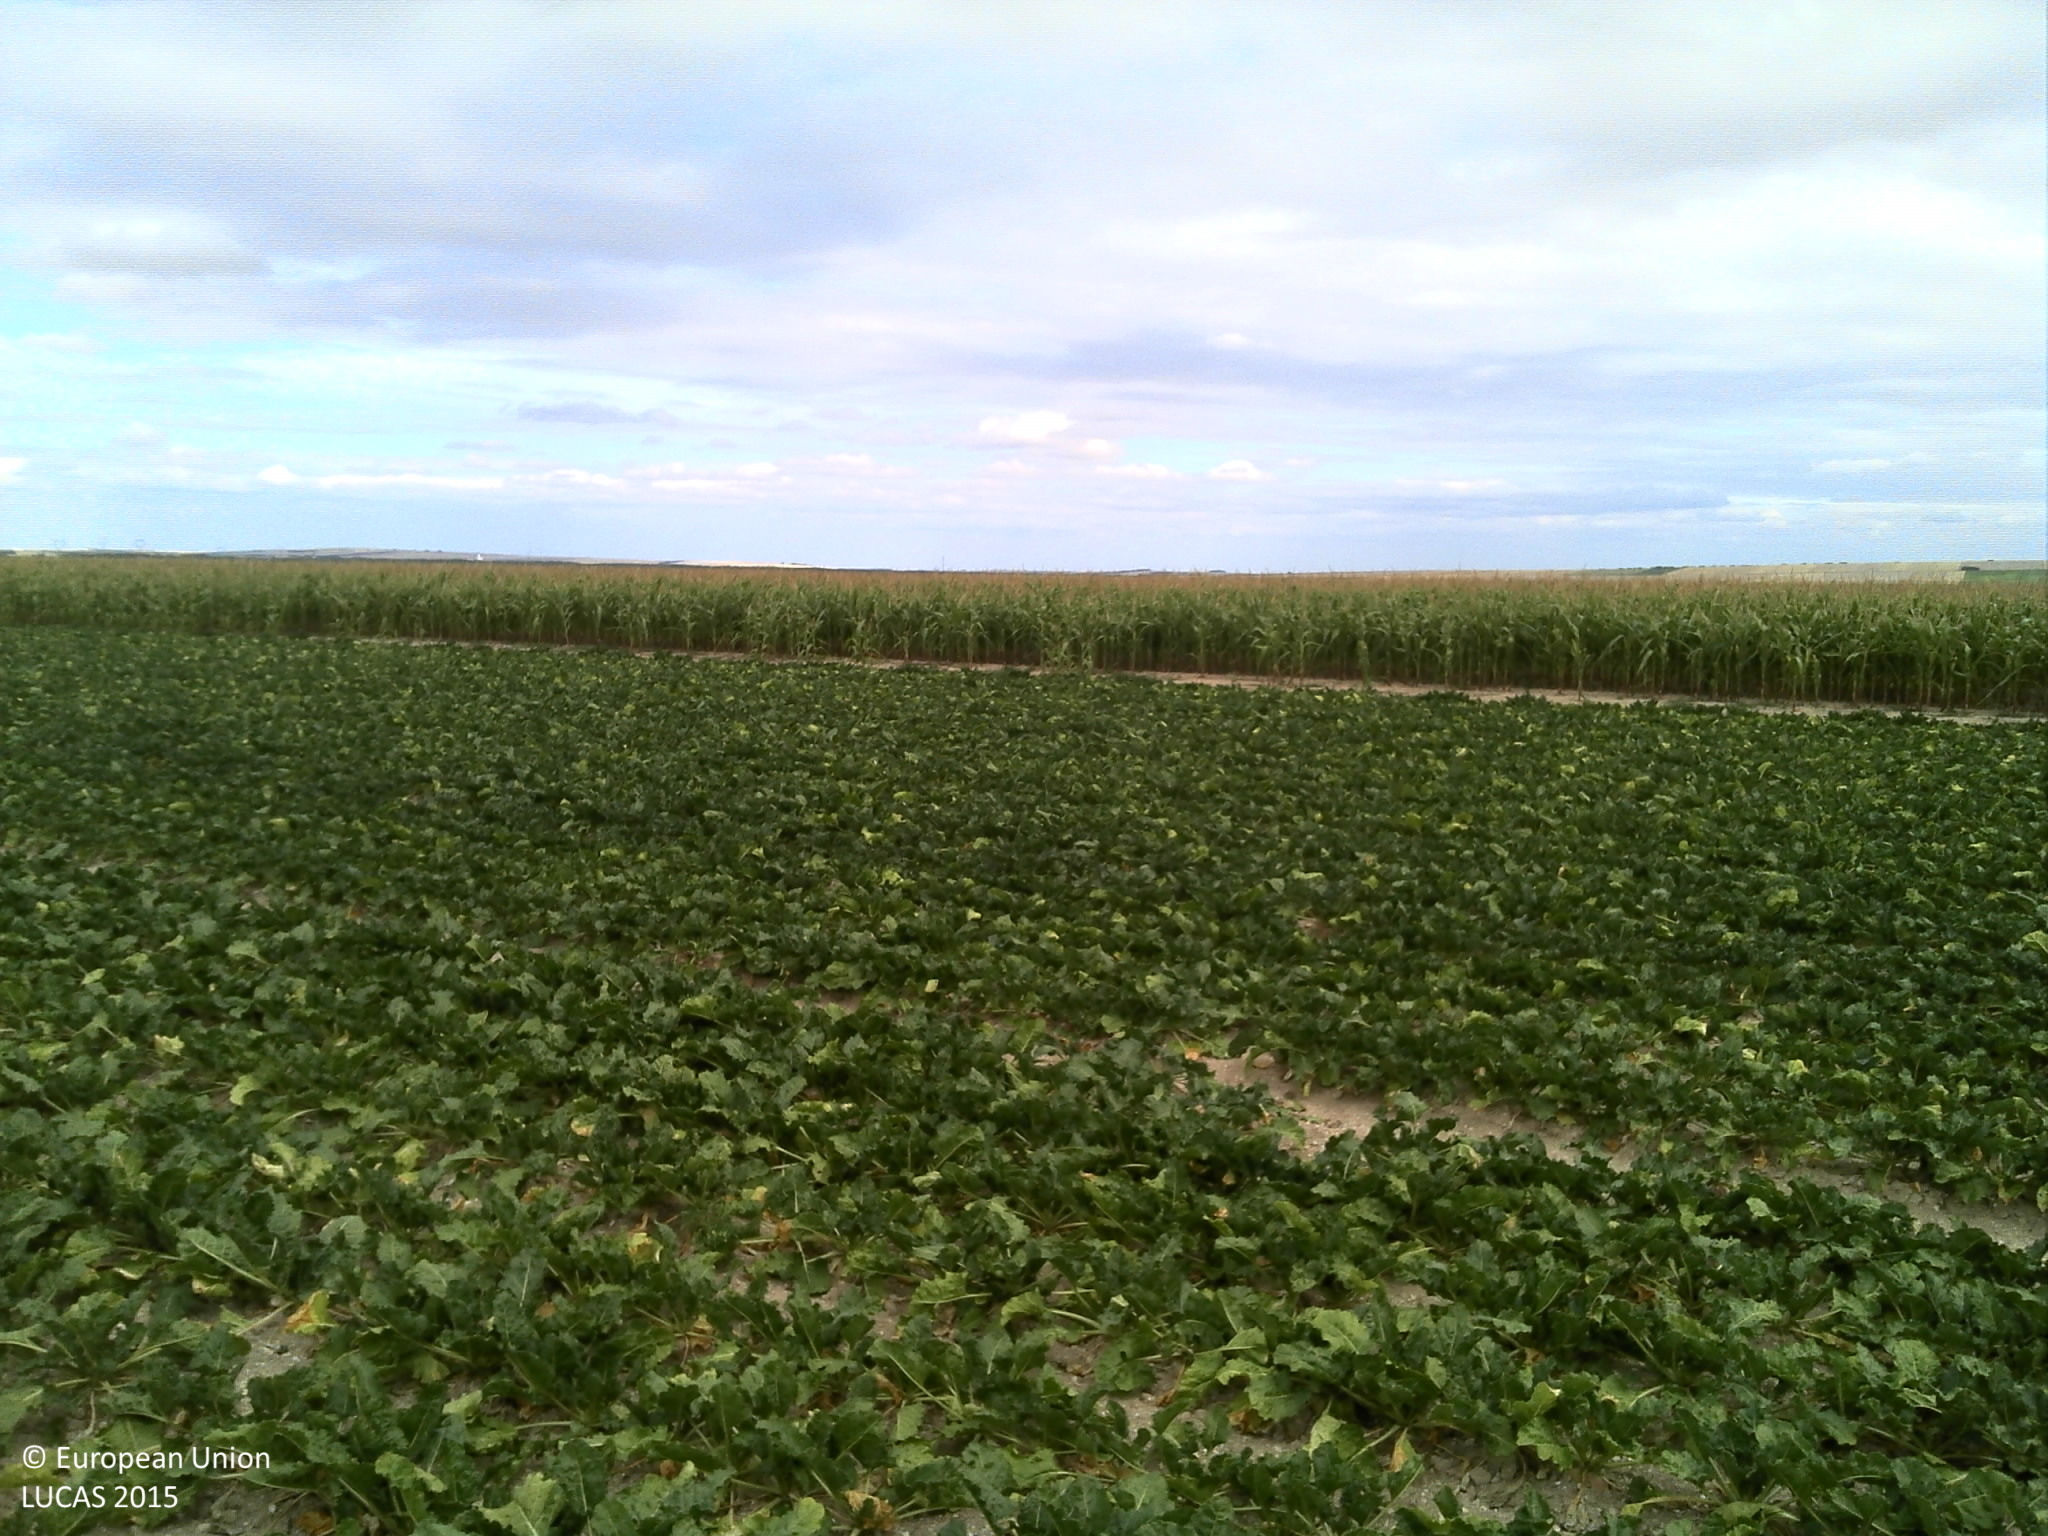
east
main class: Cropland
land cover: Sugar beet
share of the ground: 50 - 75 %
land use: Agriculture (excluding fallow land and kitchen gardens)
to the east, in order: Sugar beet; Maize; Common wheat
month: August
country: FR
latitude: 48.5047
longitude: 4.2170
